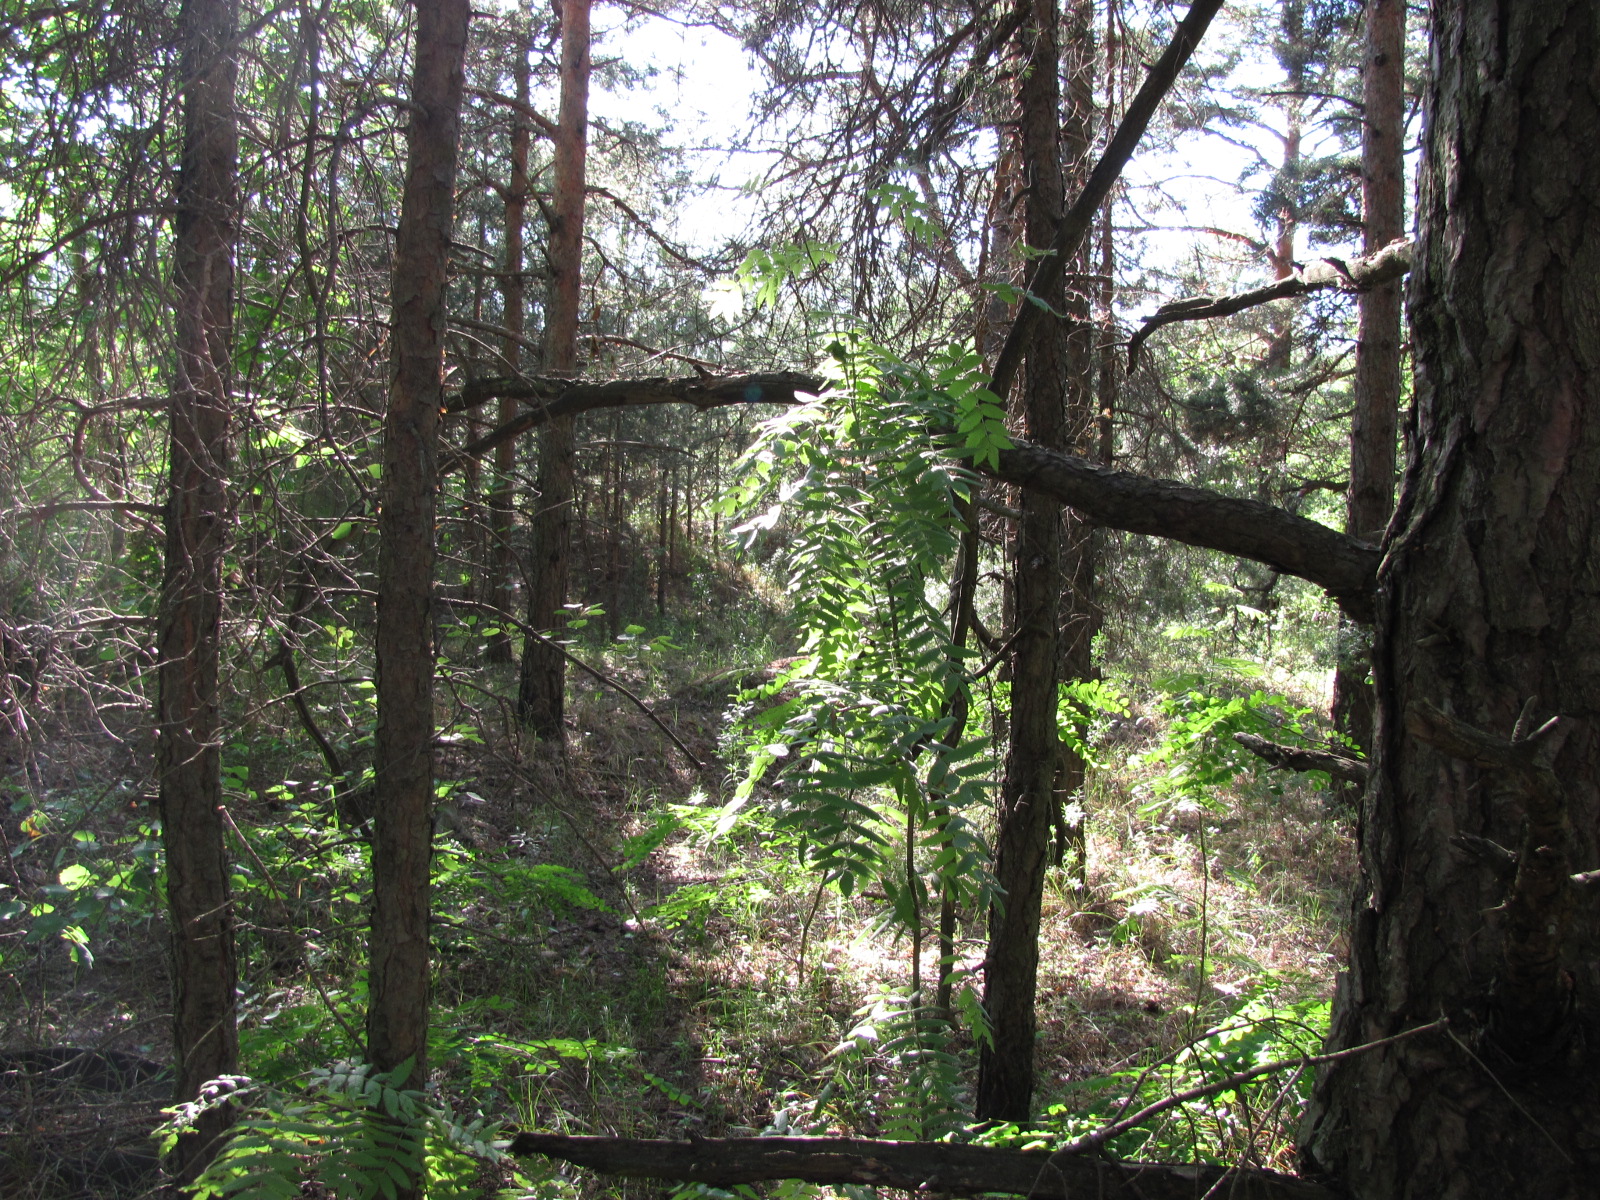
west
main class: Woodland
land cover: Pine dominated coniferous woodland
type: hemiboreal forest and nemoral coniferous forest and mixed broadleaved-coniferous forest
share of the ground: > 75 %
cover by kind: coniferous forest trees 80 %, herbaceous plants 10 %, lichens and mosses 10 %
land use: Forestry
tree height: > 5 m
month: June
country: LV
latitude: 57.0204
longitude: 24.0350
